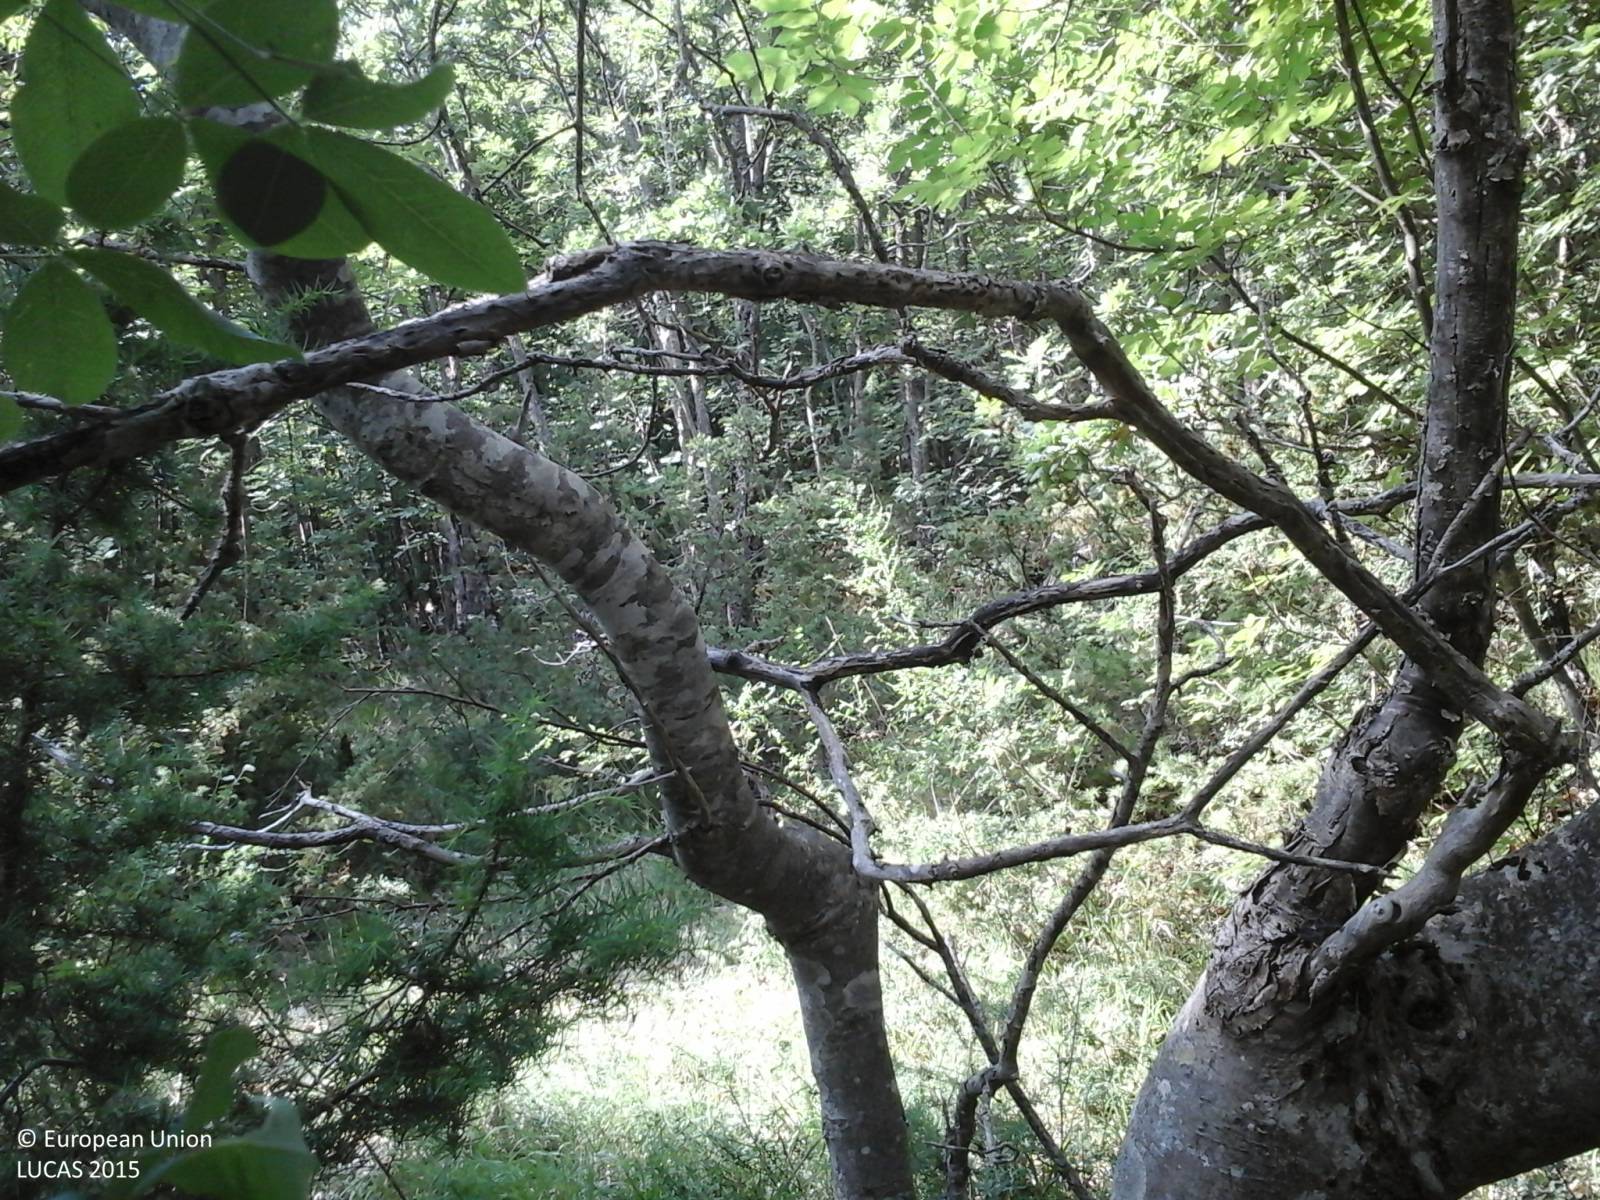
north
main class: Woodland
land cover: Broadleaved woodland
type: thermophilous deciduous forest
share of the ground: > 75 %
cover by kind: broadleaved forest trees 100 %
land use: Forestry
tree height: > 5 m
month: July
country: IT
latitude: 42.4600
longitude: 13.1638
